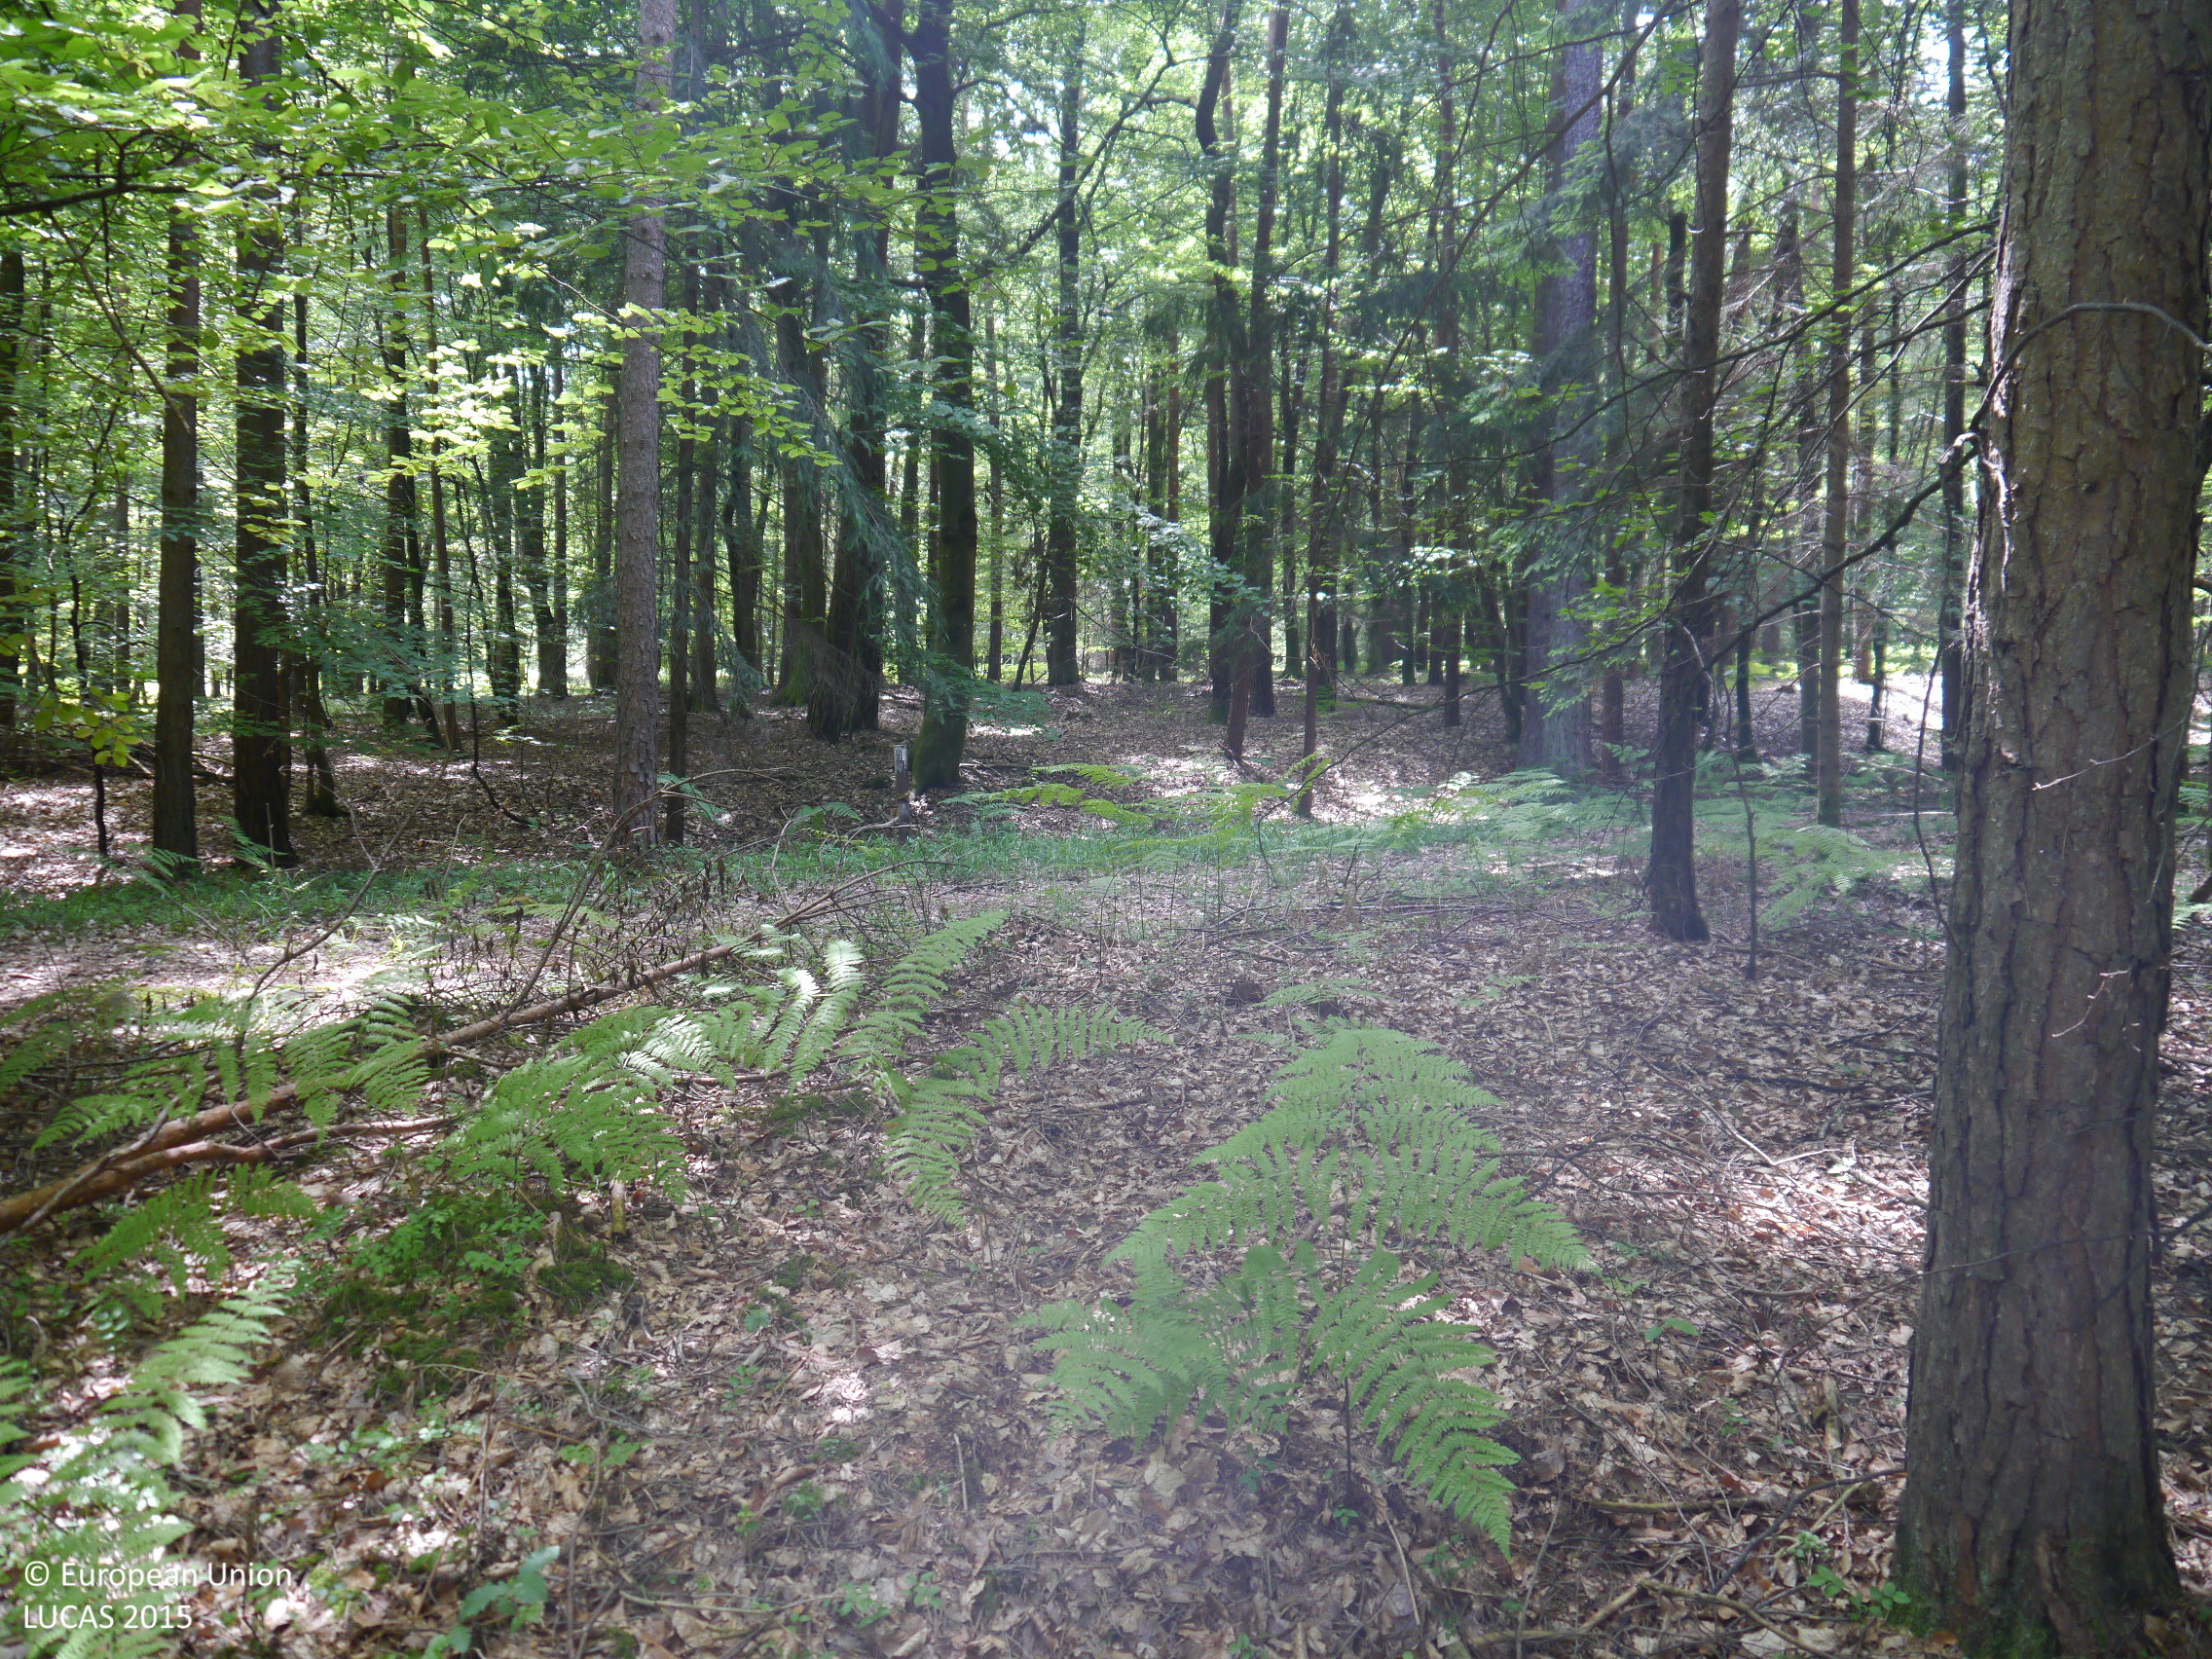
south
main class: Woodland
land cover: Pine dominated mixed woodland
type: hemiboreal forest and nemoral coniferous forest and mixed broadleaved-coniferous forest
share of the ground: > 75 %
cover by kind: broadleaved forest trees 50 %, coniferous forest trees 45 %, herbaceous plants 5 %
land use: Forestry
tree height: > 5 m
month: June
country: AT
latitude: 46.8668
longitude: 15.7066
